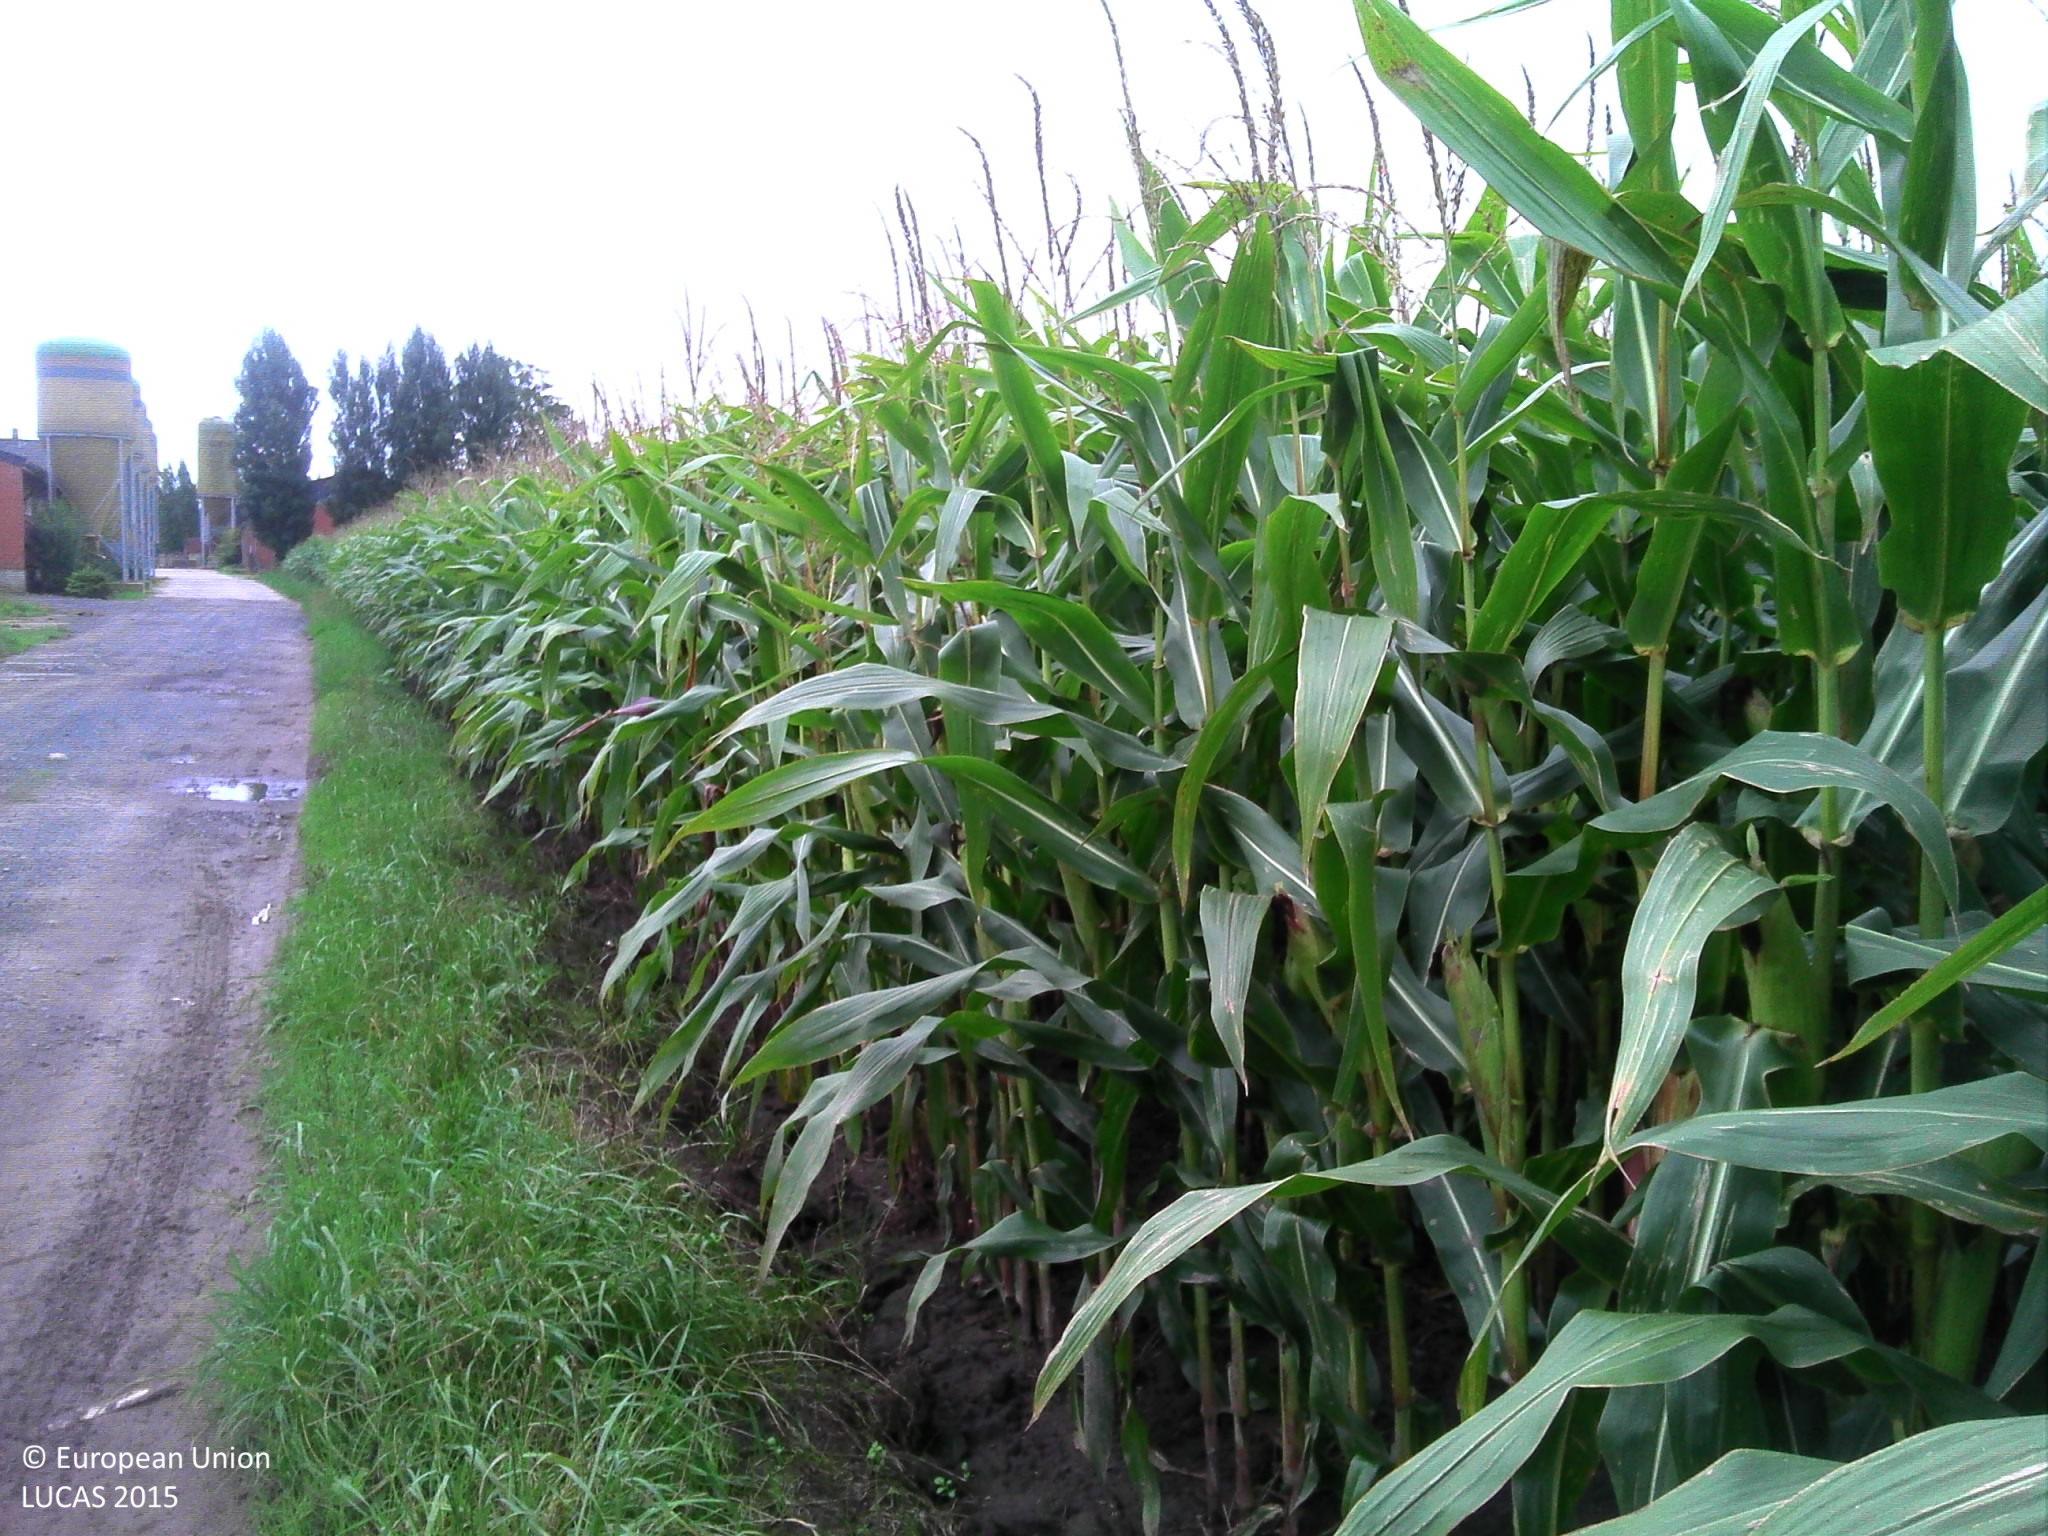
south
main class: Cropland
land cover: Maize
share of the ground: > 75 %
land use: Agriculture (excluding fallow land and kitchen gardens)
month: September
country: BE
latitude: 51.0851
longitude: 2.9516
